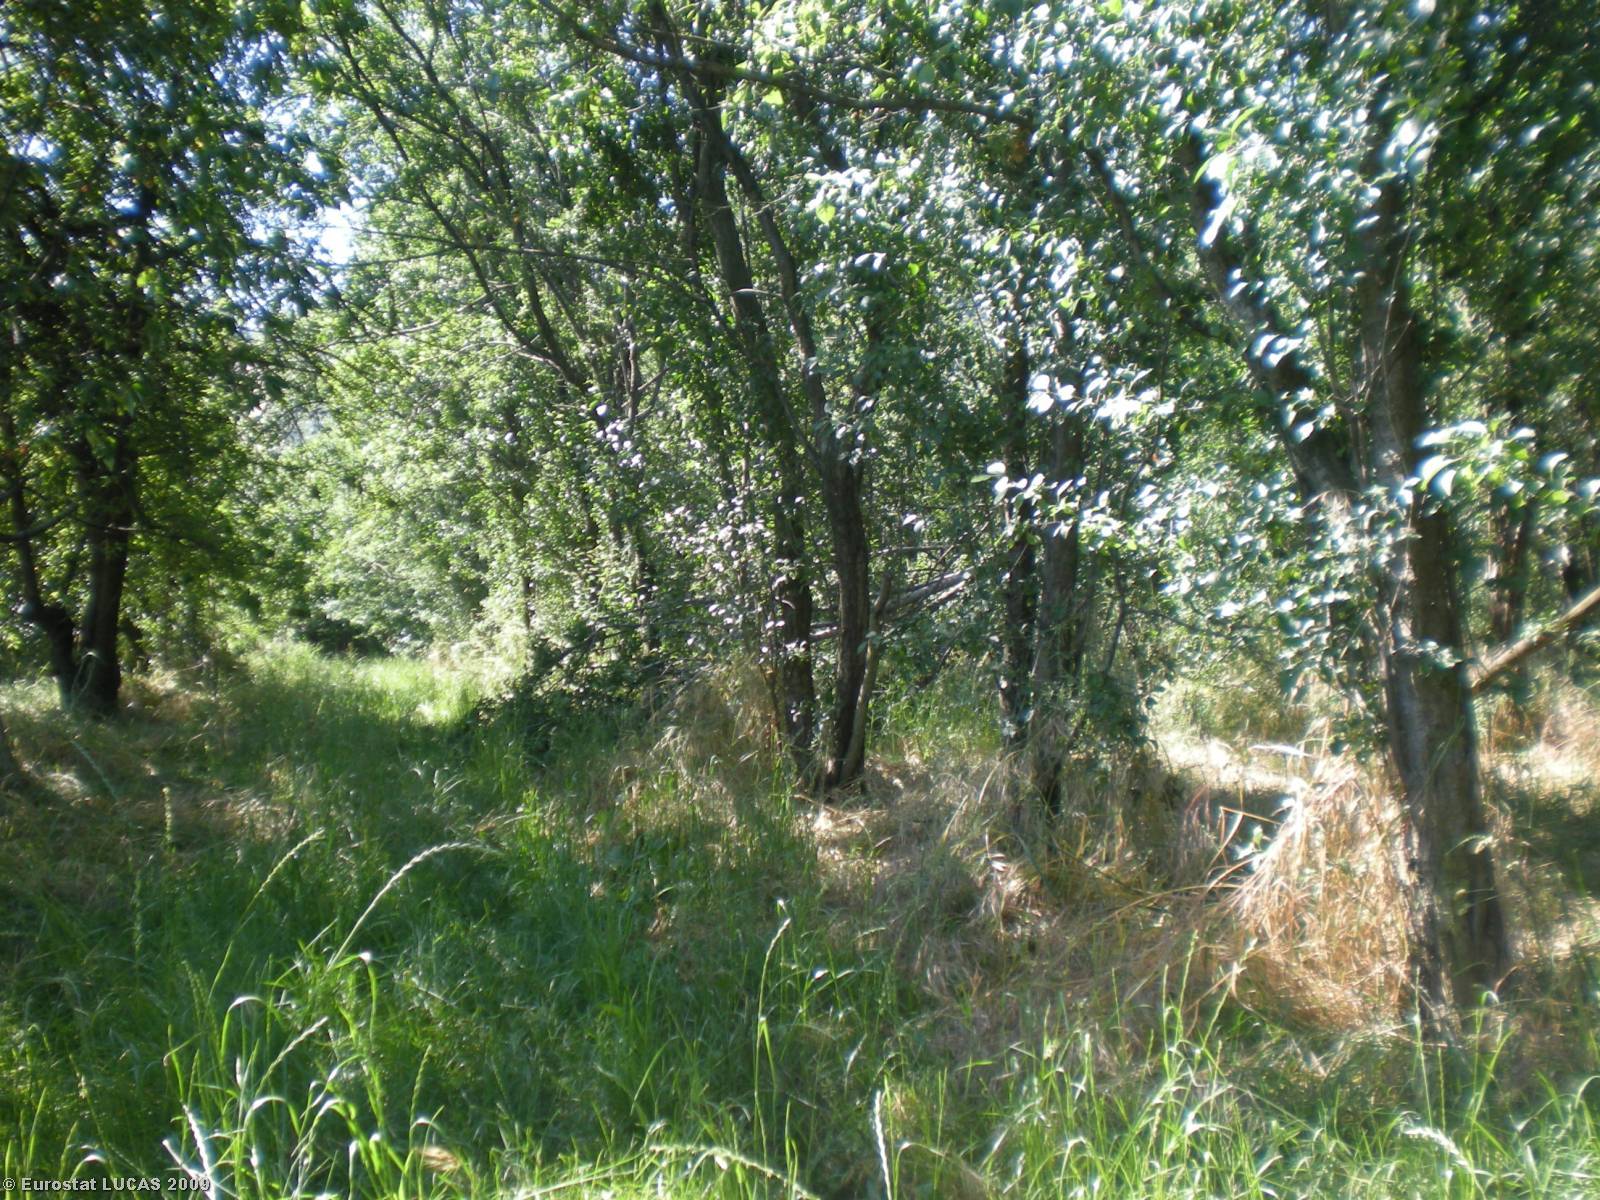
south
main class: Cropland
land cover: Other fruit trees and berries
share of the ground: 50 - 75 %
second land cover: Grassland with sparse tree/shrub cover
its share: > 75 %
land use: Agriculture (excluding fallow land and kitchen gardens)
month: June
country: IT
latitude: 44.7315
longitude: 7.3407
